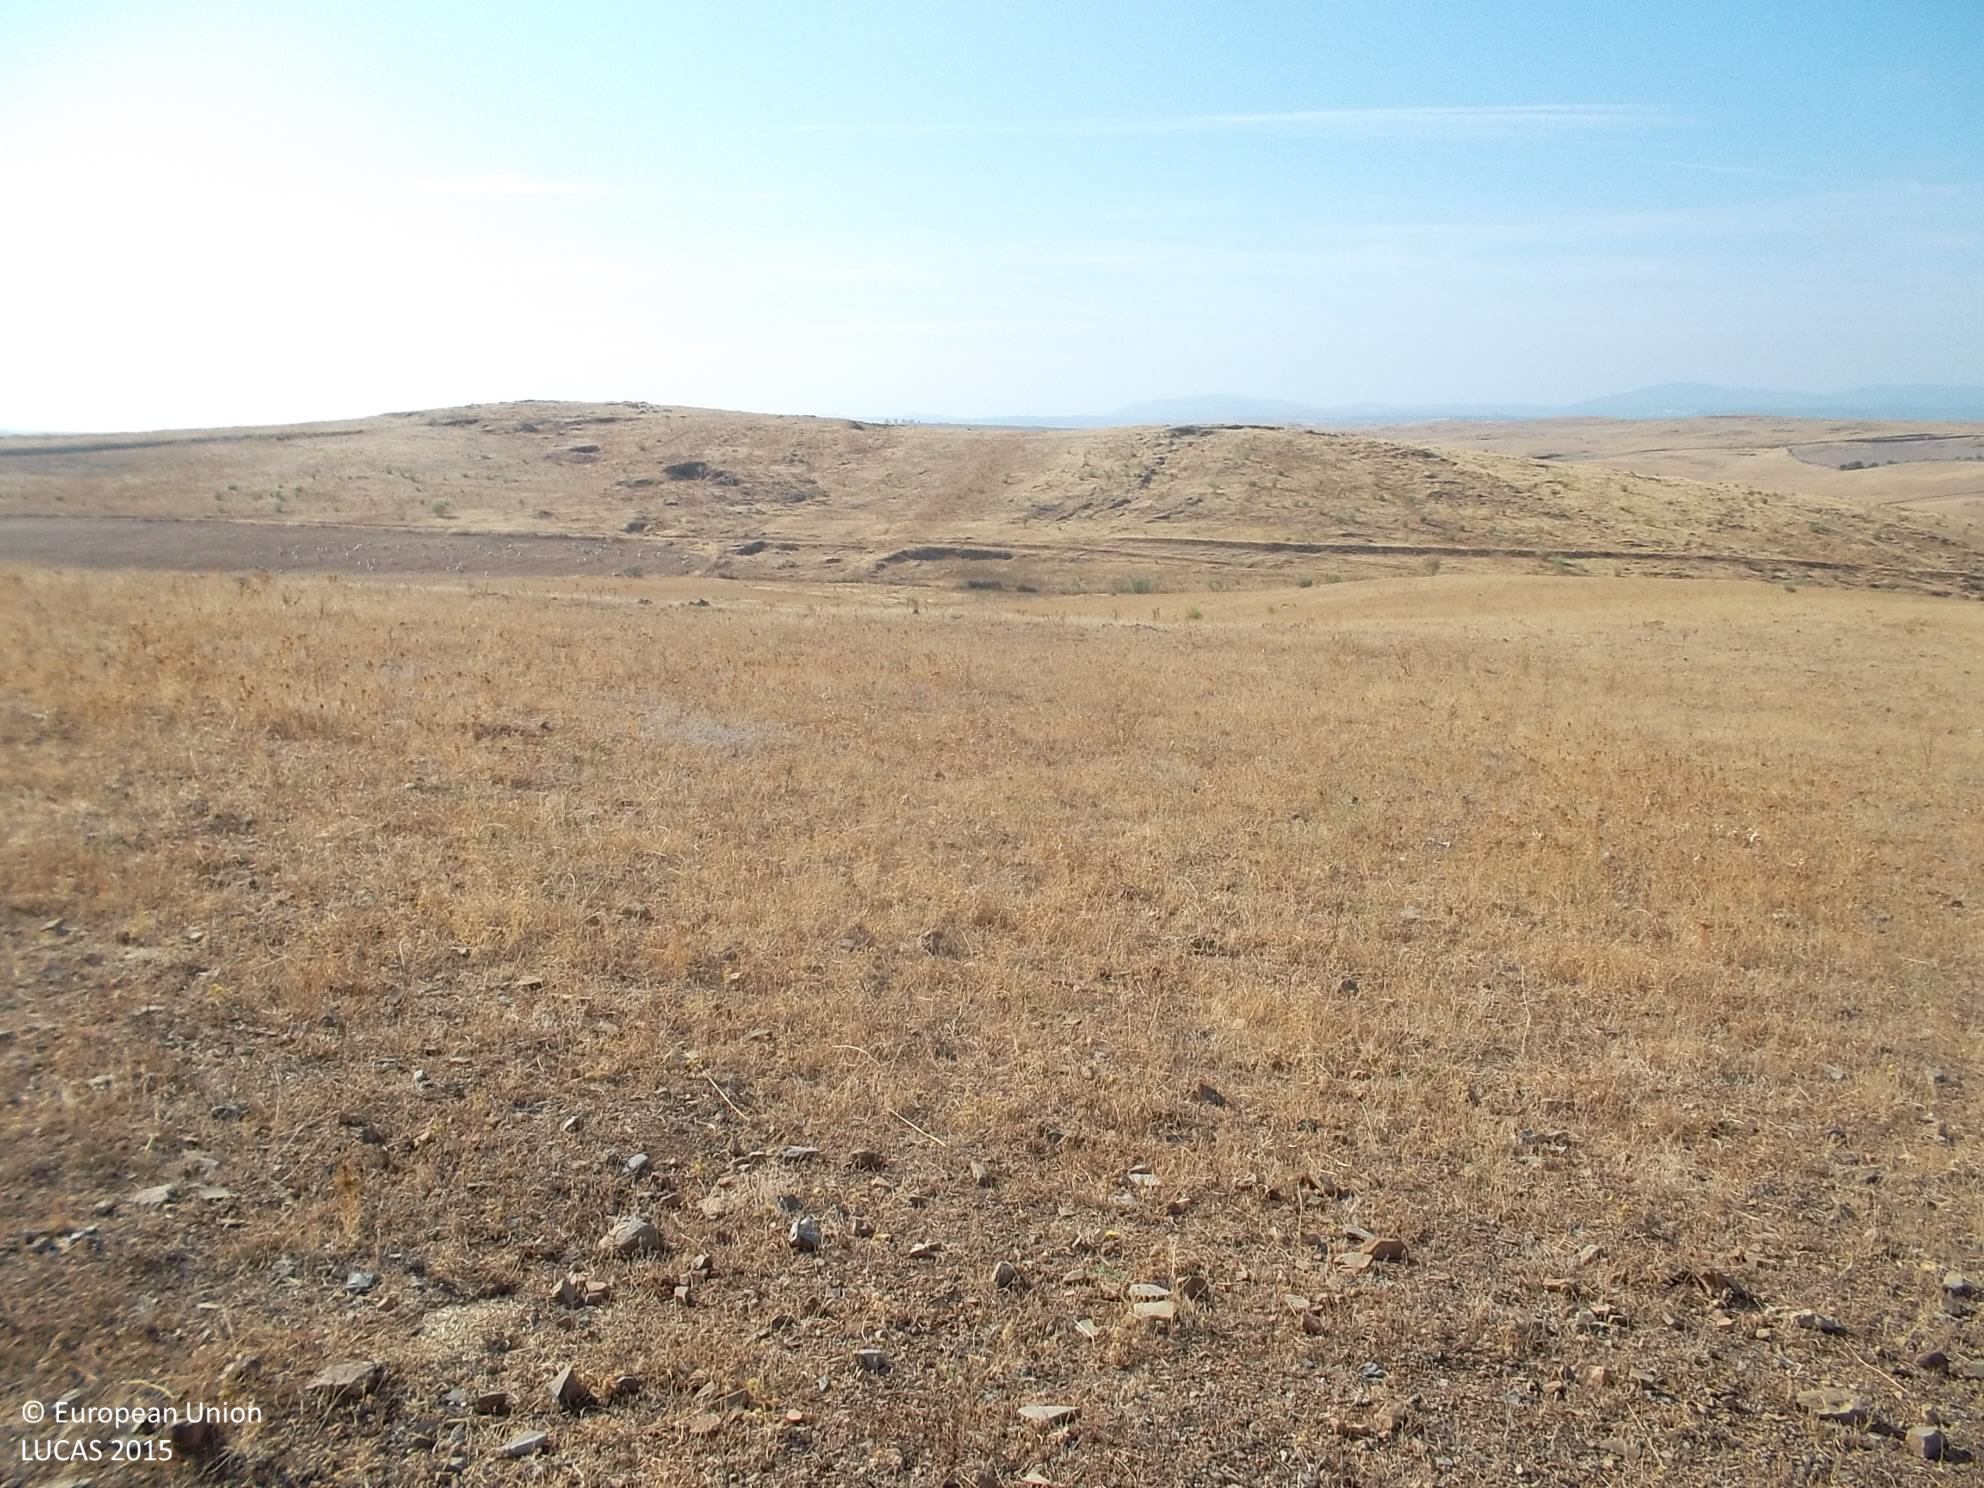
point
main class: Grassland
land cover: Spontaneously vegetated surfaces
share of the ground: > 75 %
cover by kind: herbaceous plants 100 %
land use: Fallow land
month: September
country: ES
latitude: 38.2442
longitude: -6.3275
